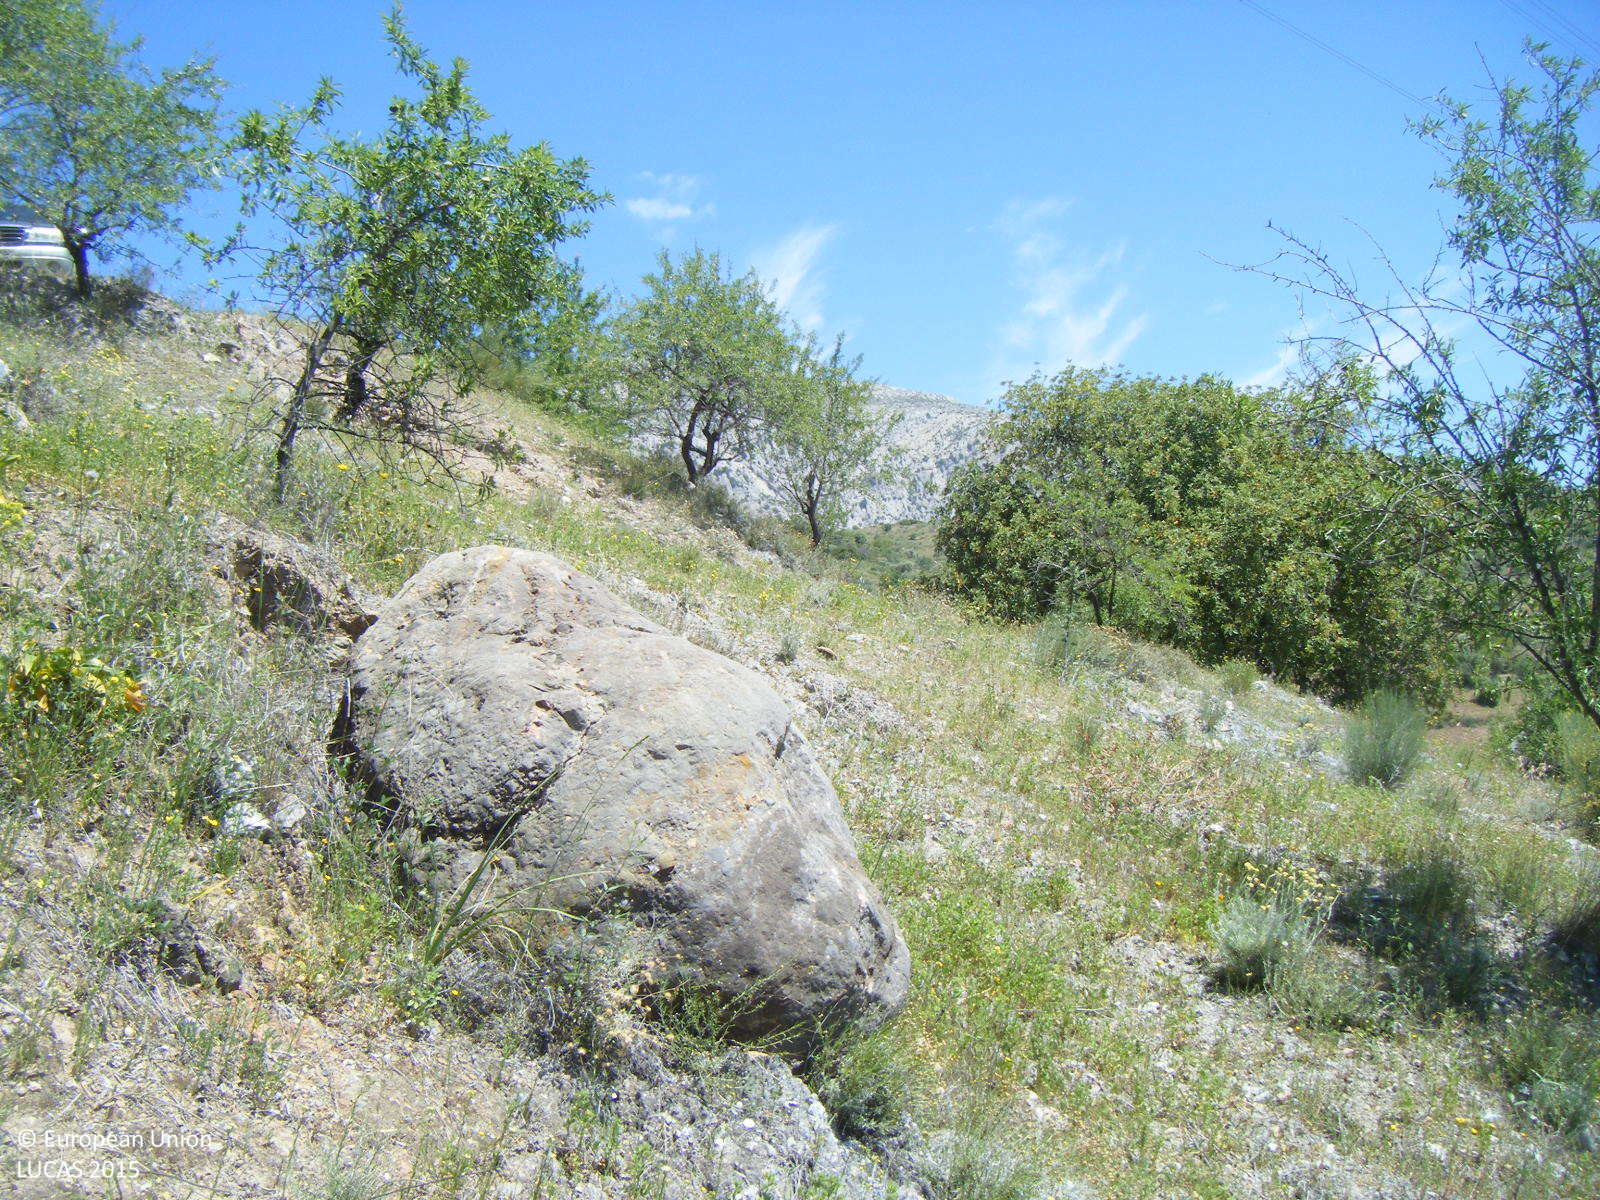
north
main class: Cropland
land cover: Olive groves
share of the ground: 10 - 25 %
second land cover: Spontaneously vegetated surfaces
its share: > 75 %
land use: Agriculture (excluding fallow land and kitchen gardens)
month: May
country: ES
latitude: 36.9095
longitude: -4.7109
